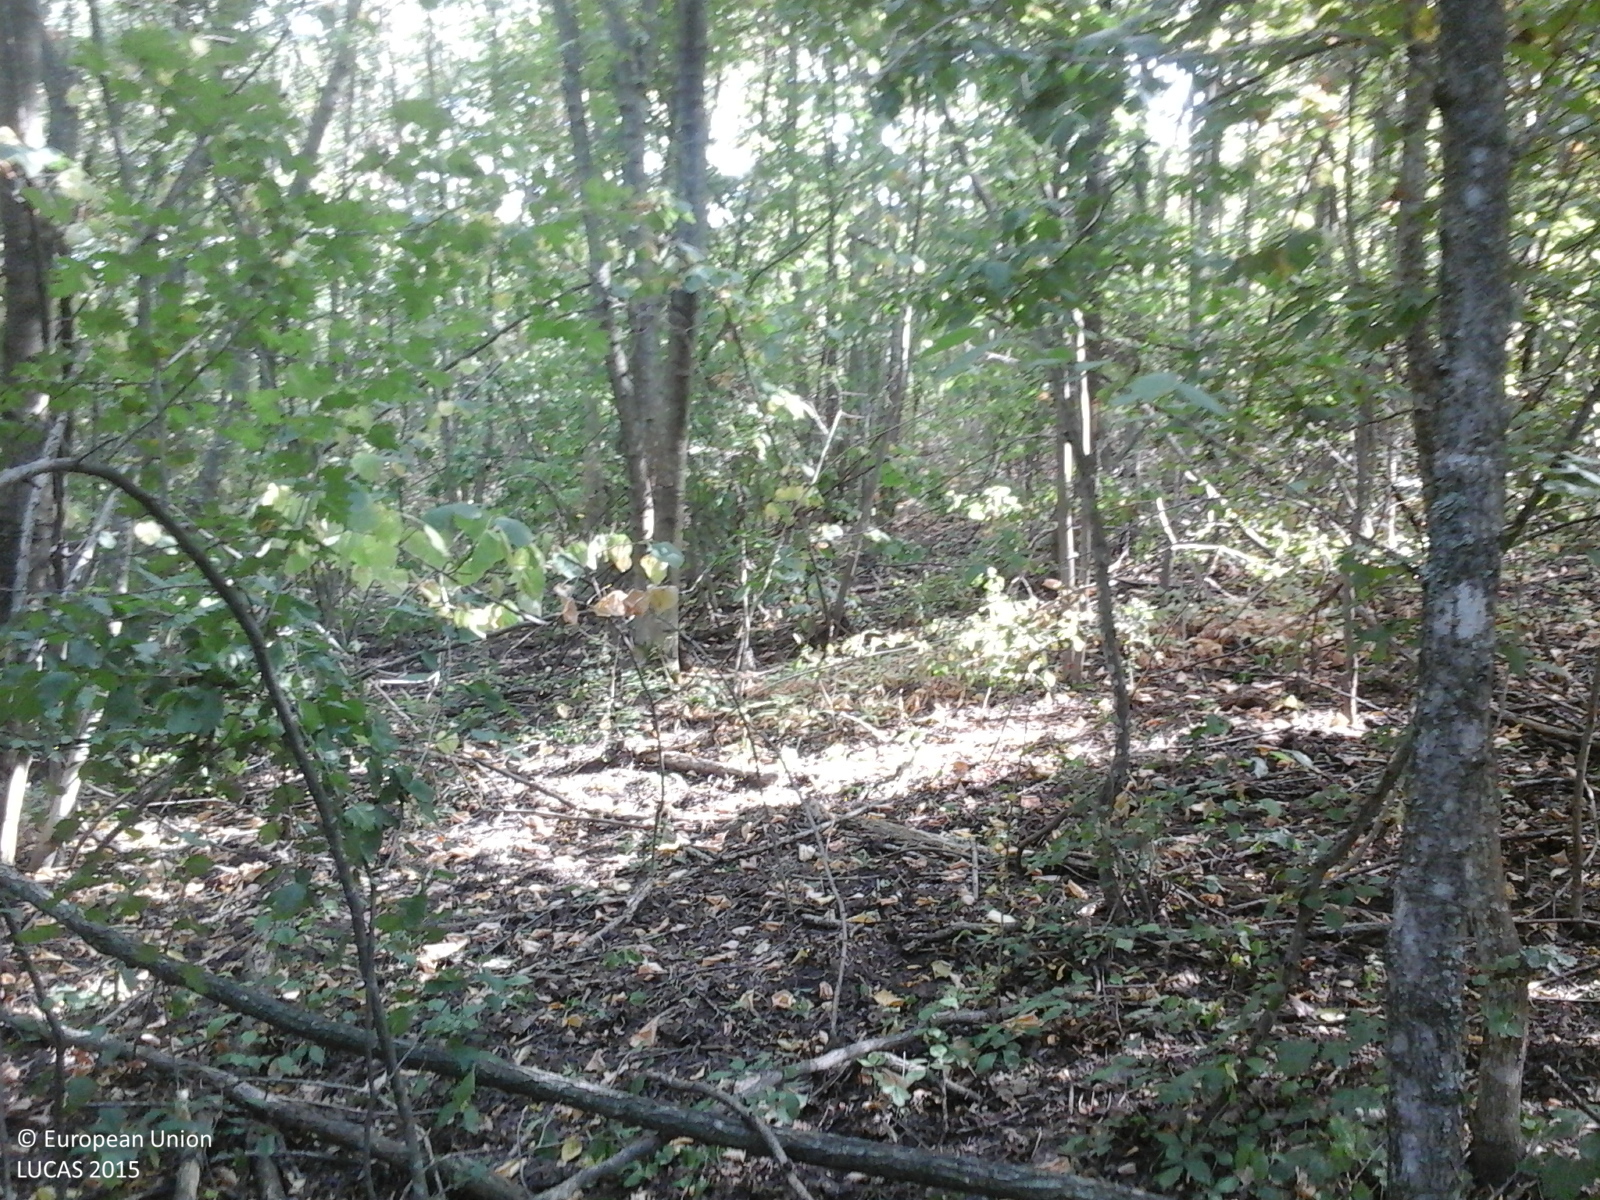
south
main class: Woodland
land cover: Broadleaved woodland
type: acidophilous oak and oak-birch forest
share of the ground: > 75 %
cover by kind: broadleaved forest trees 100 %
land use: Forestry
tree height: > 5 m
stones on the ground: < 10 %
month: July
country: RO
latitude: 46.2484
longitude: 27.8771
